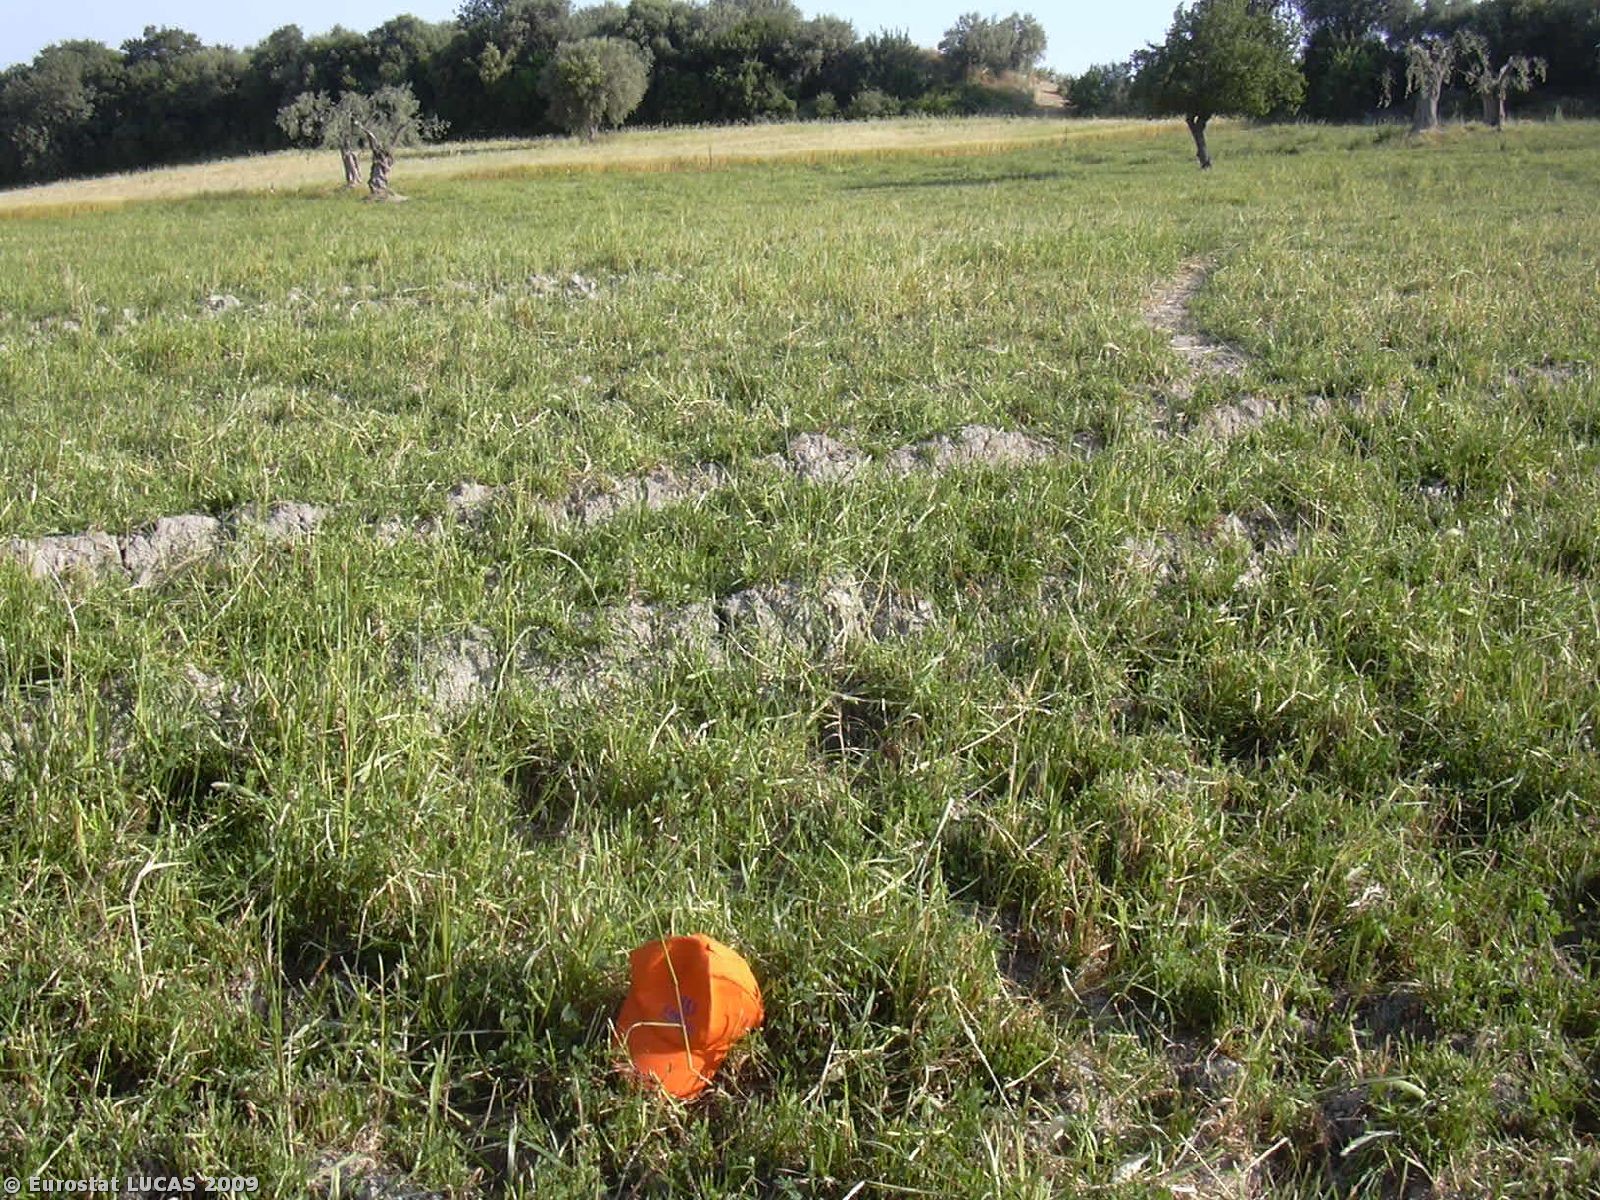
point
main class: Cropland
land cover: Mixed cereals for fodder
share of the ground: 50 - 75 %
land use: Agriculture (excluding fallow land and kitchen gardens)
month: May
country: IT
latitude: 36.9667
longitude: 14.8926
